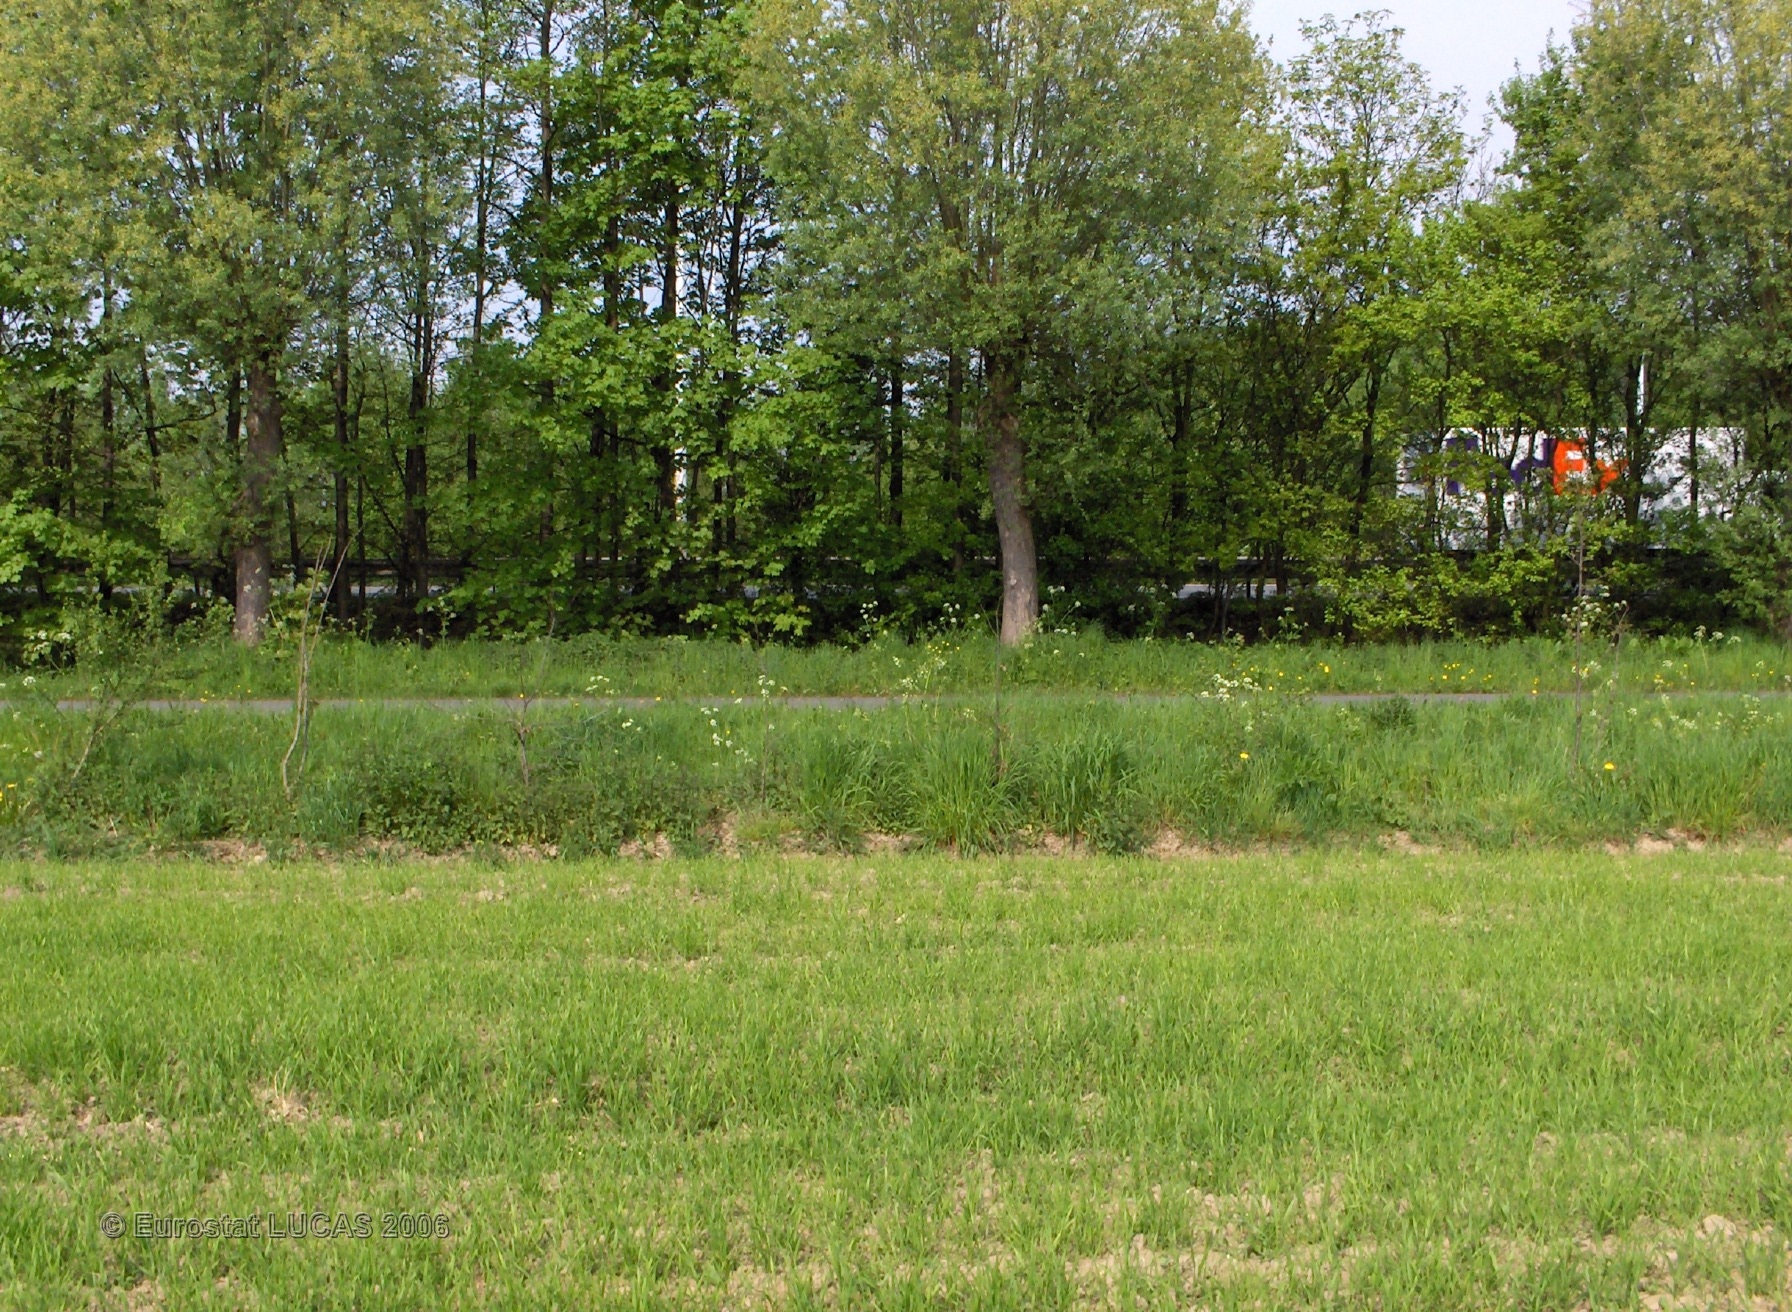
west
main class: Cropland
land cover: Common wheat
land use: Agriculture (excluding fallow land and kitchen gardens)
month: May
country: BE
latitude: 50.9520
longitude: 4.4868
